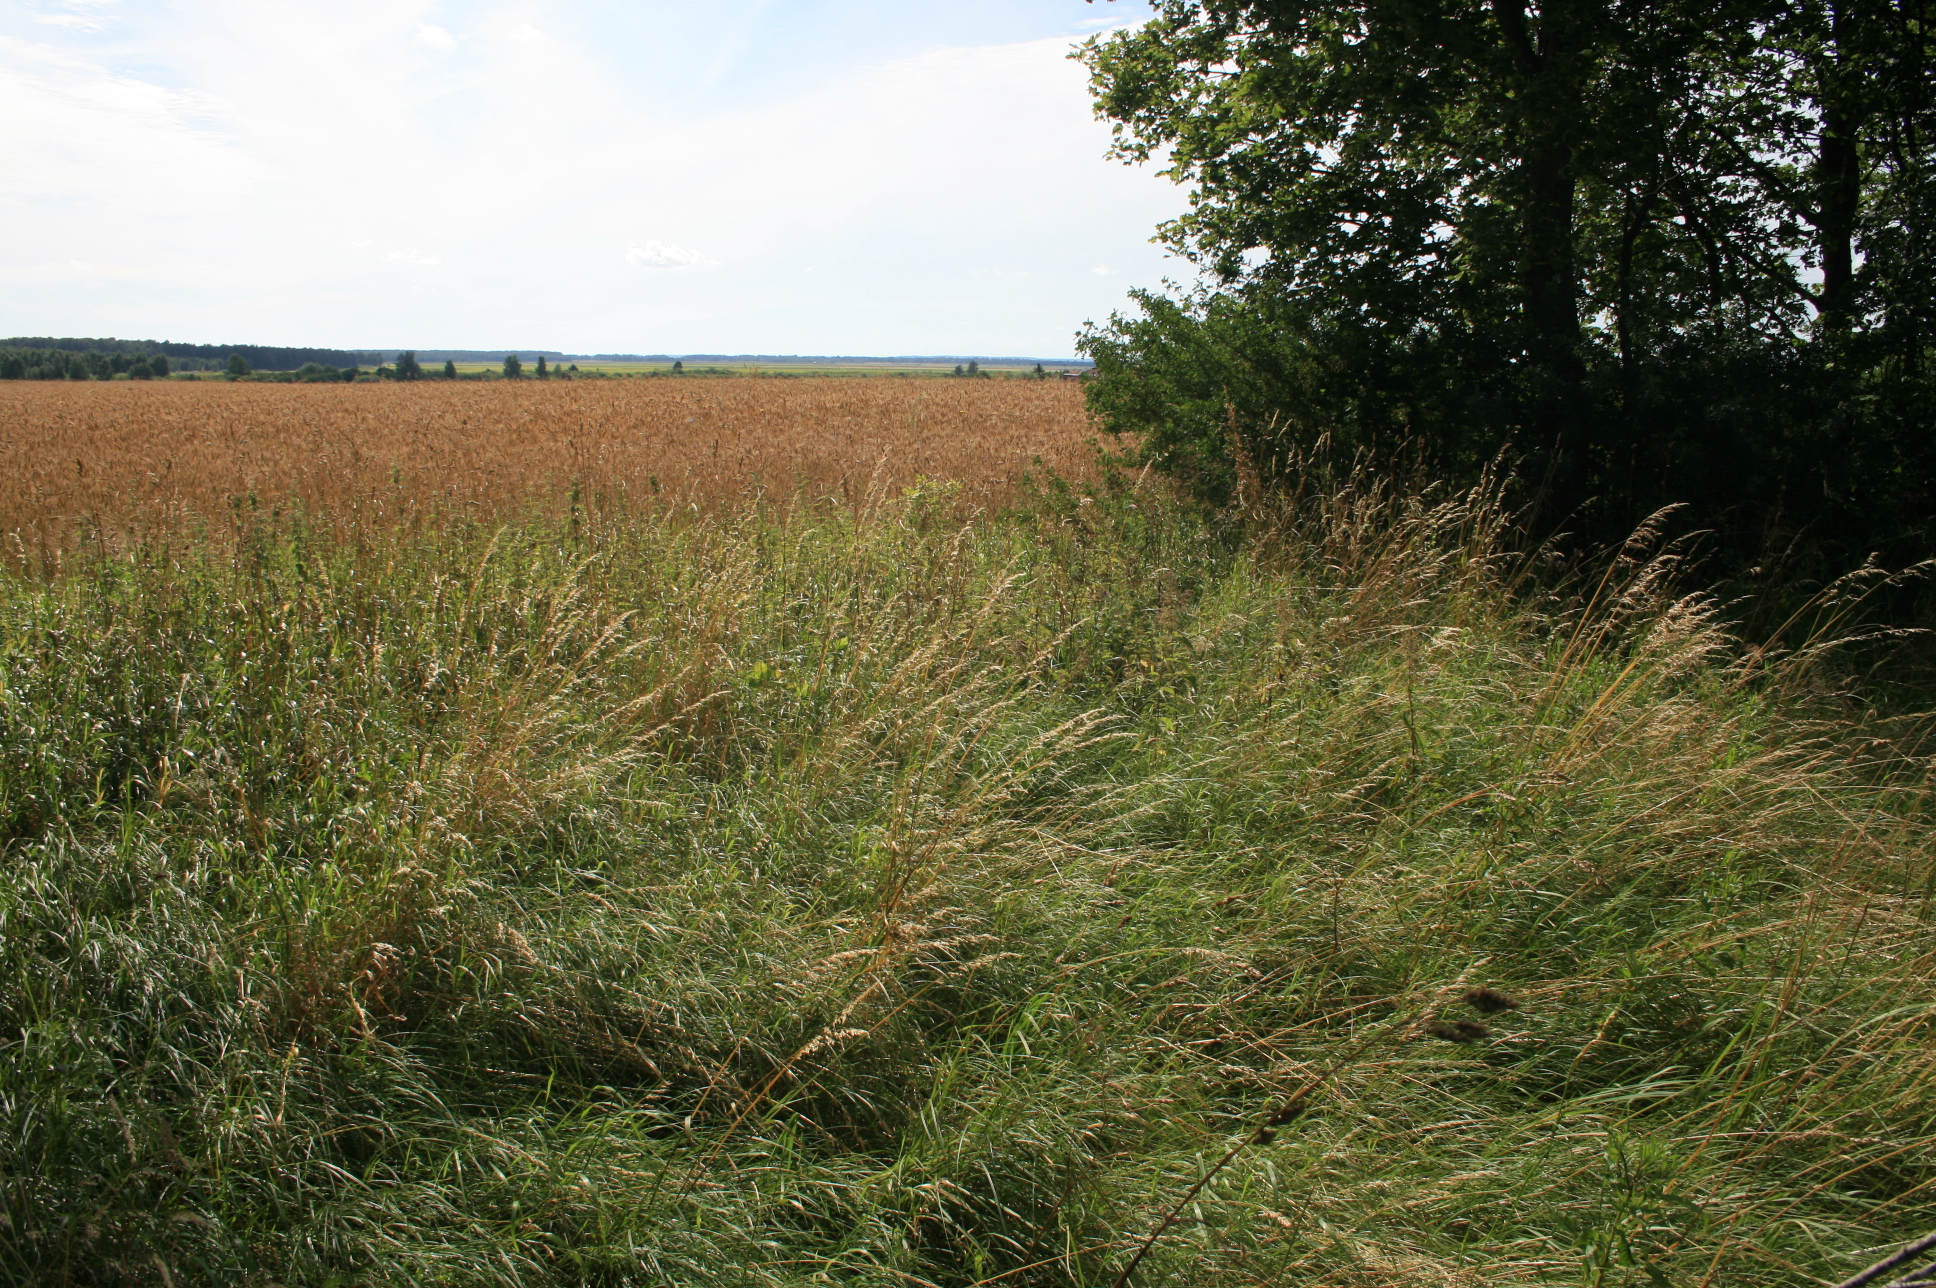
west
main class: Grassland
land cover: Grassland with sparse tree/shrub cover
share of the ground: > 75 %
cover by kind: herbaceous plants 90 %, broadleaved forest trees 5 %, shrubs 5 %
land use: Fallow land
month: July
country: LT
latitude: 55.5023
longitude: 21.3314
